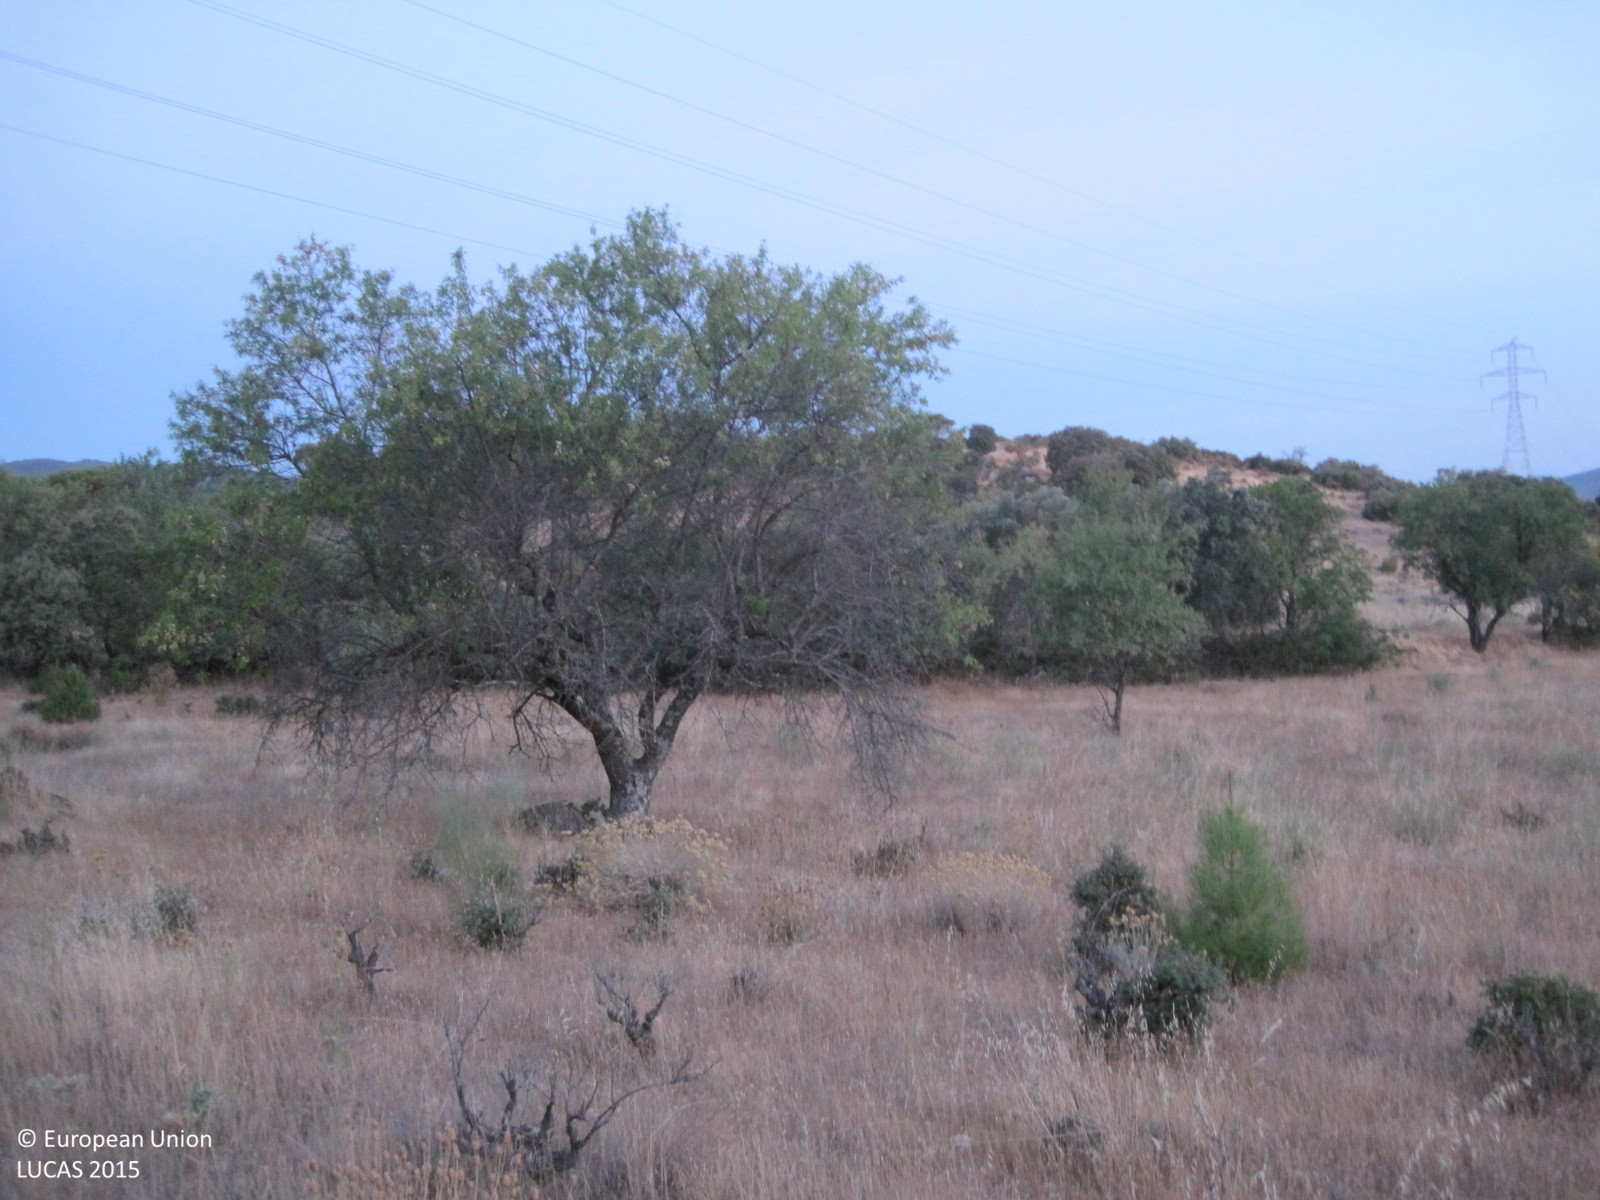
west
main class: Woodland
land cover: Pine dominated coniferous woodland
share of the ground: 25 - 50 %
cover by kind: herbaceous plants 75 %, coniferous forest trees 25 %
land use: Semi-natural and natural areas not in use
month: July
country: ES
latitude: 40.3899
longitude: -4.4077
